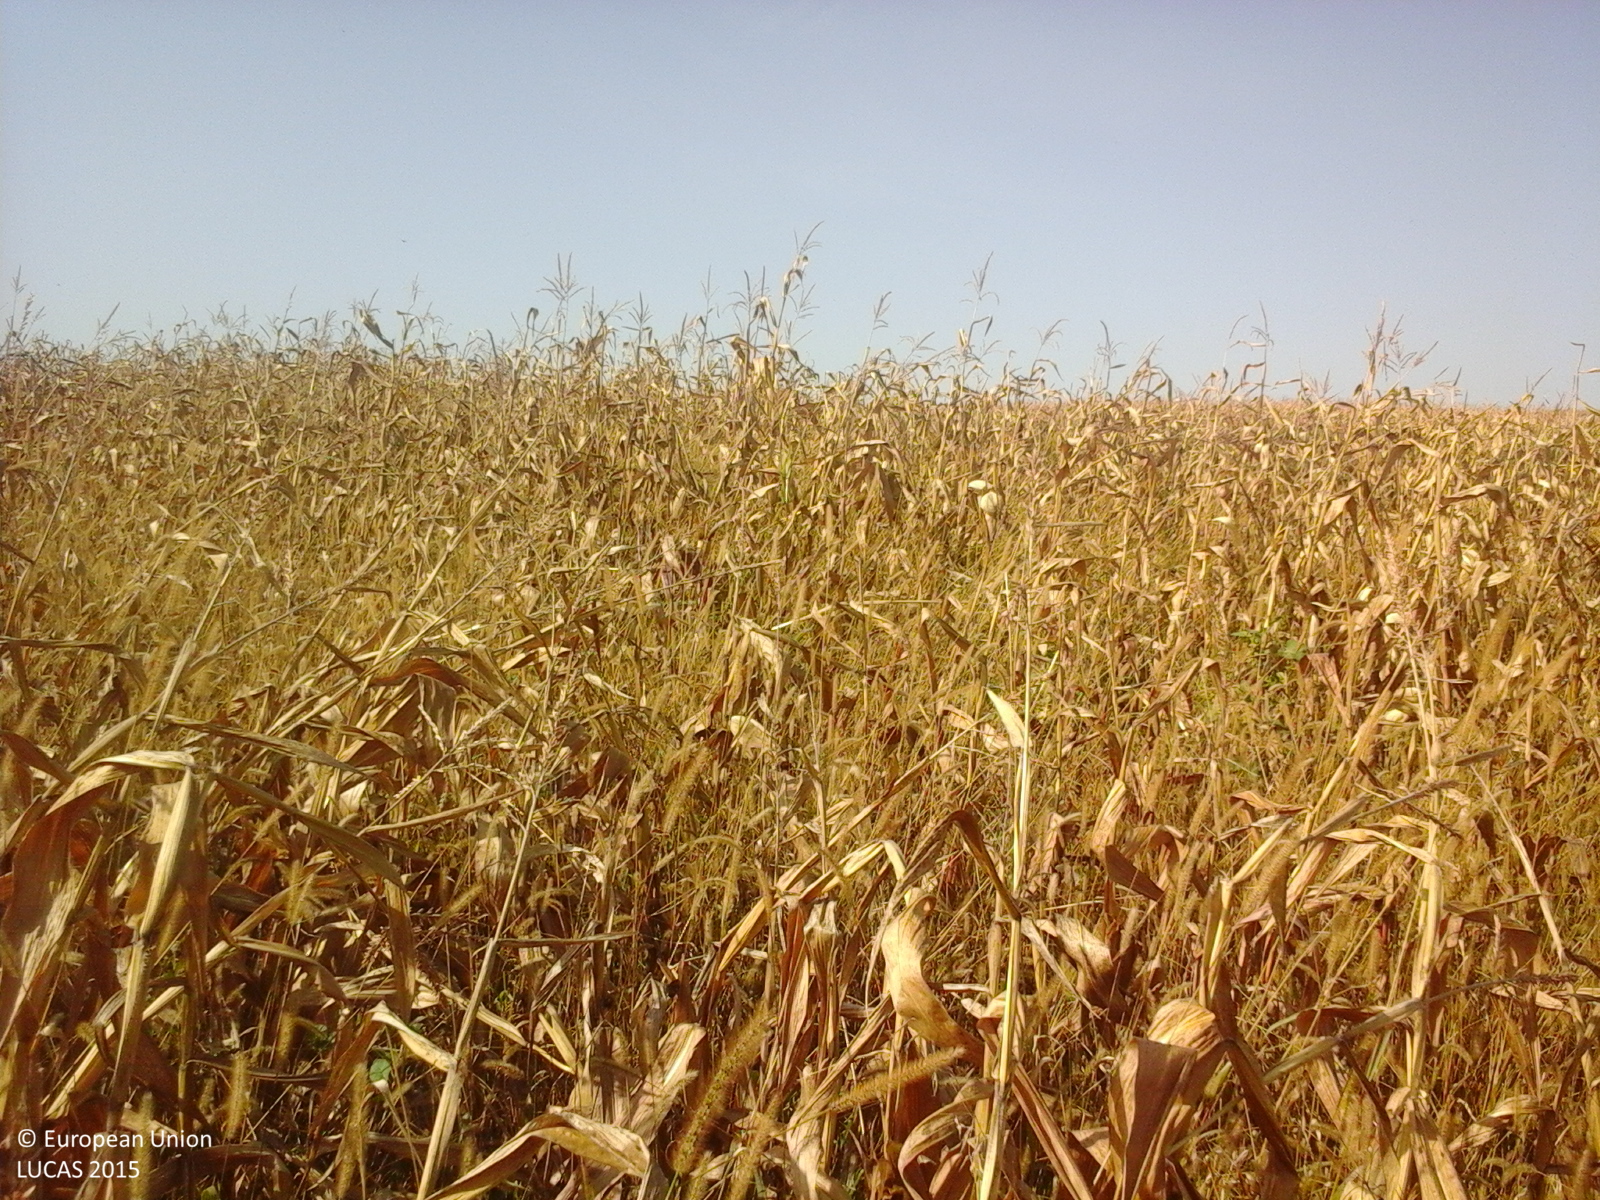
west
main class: Cropland
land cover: Maize
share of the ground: > 75 %
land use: Agriculture (excluding fallow land and kitchen gardens)
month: September
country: RO
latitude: 46.6749
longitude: 24.0799
